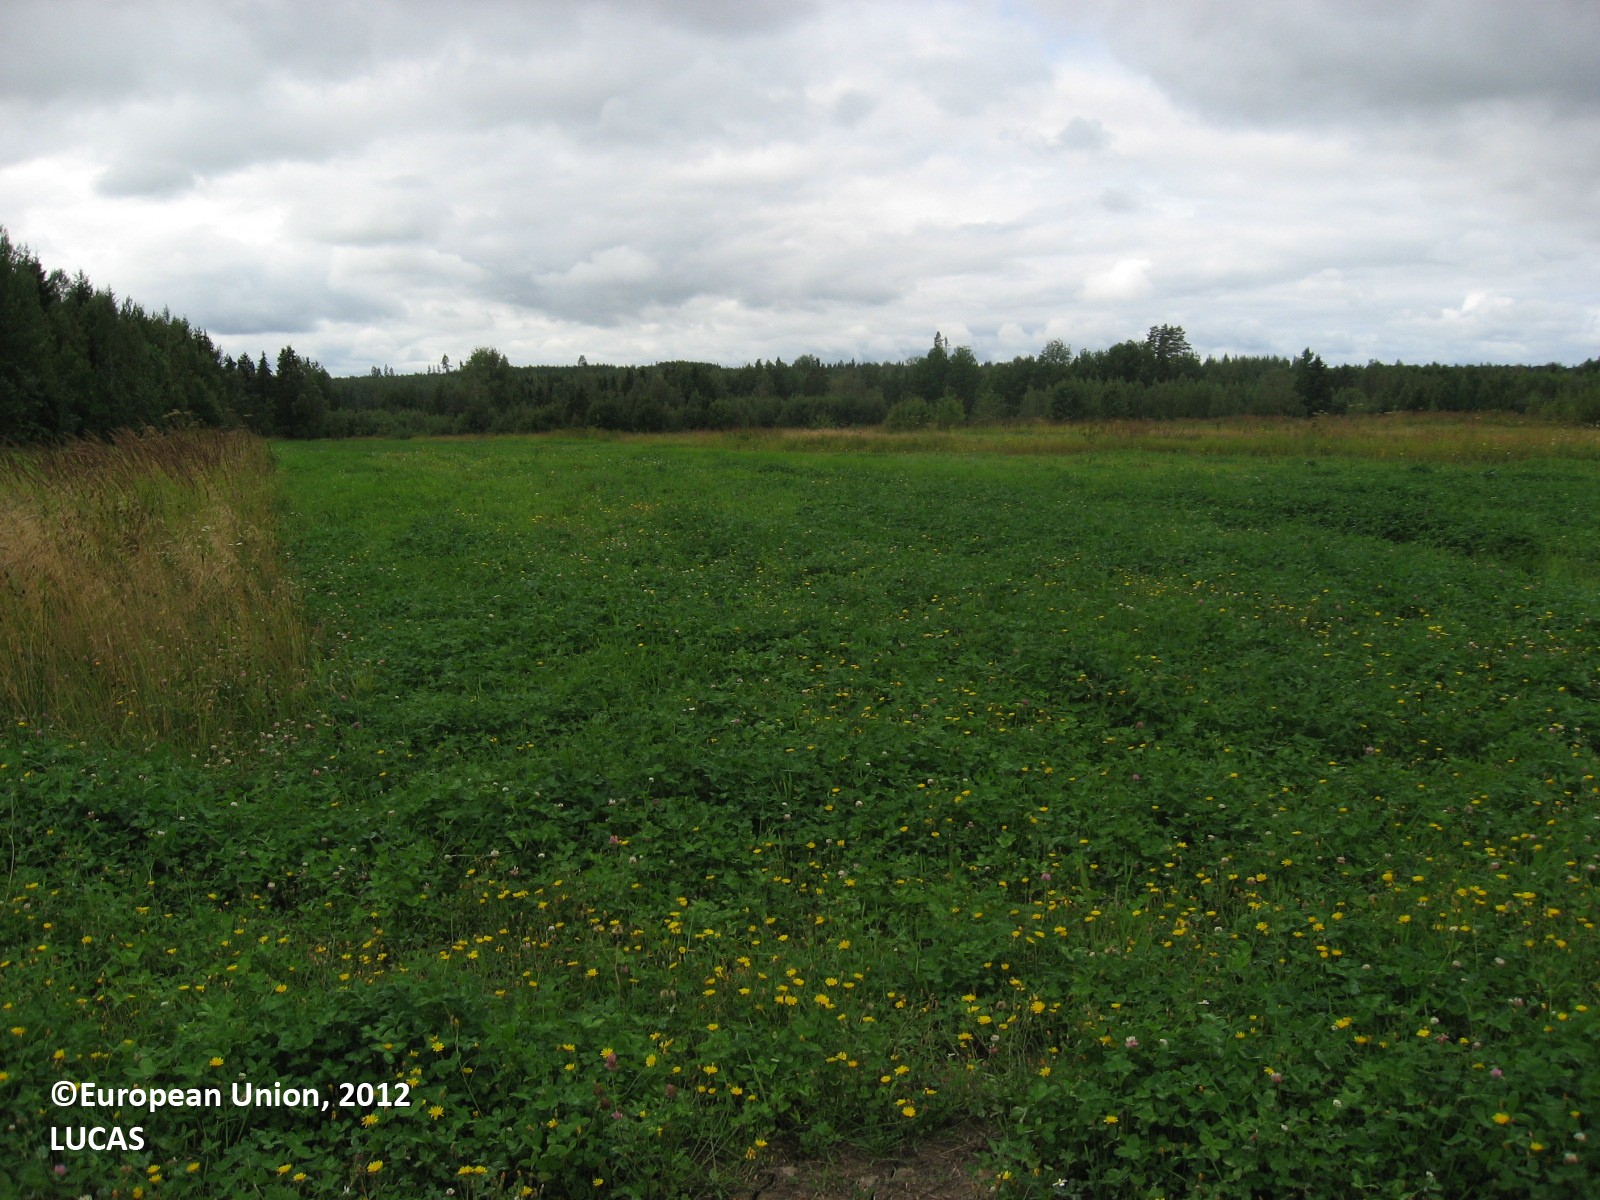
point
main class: Cropland
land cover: Clovers
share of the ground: > 75 %
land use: Agriculture (excluding fallow land and kitchen gardens)
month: August
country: FI
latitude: 60.6891
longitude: 25.5667
